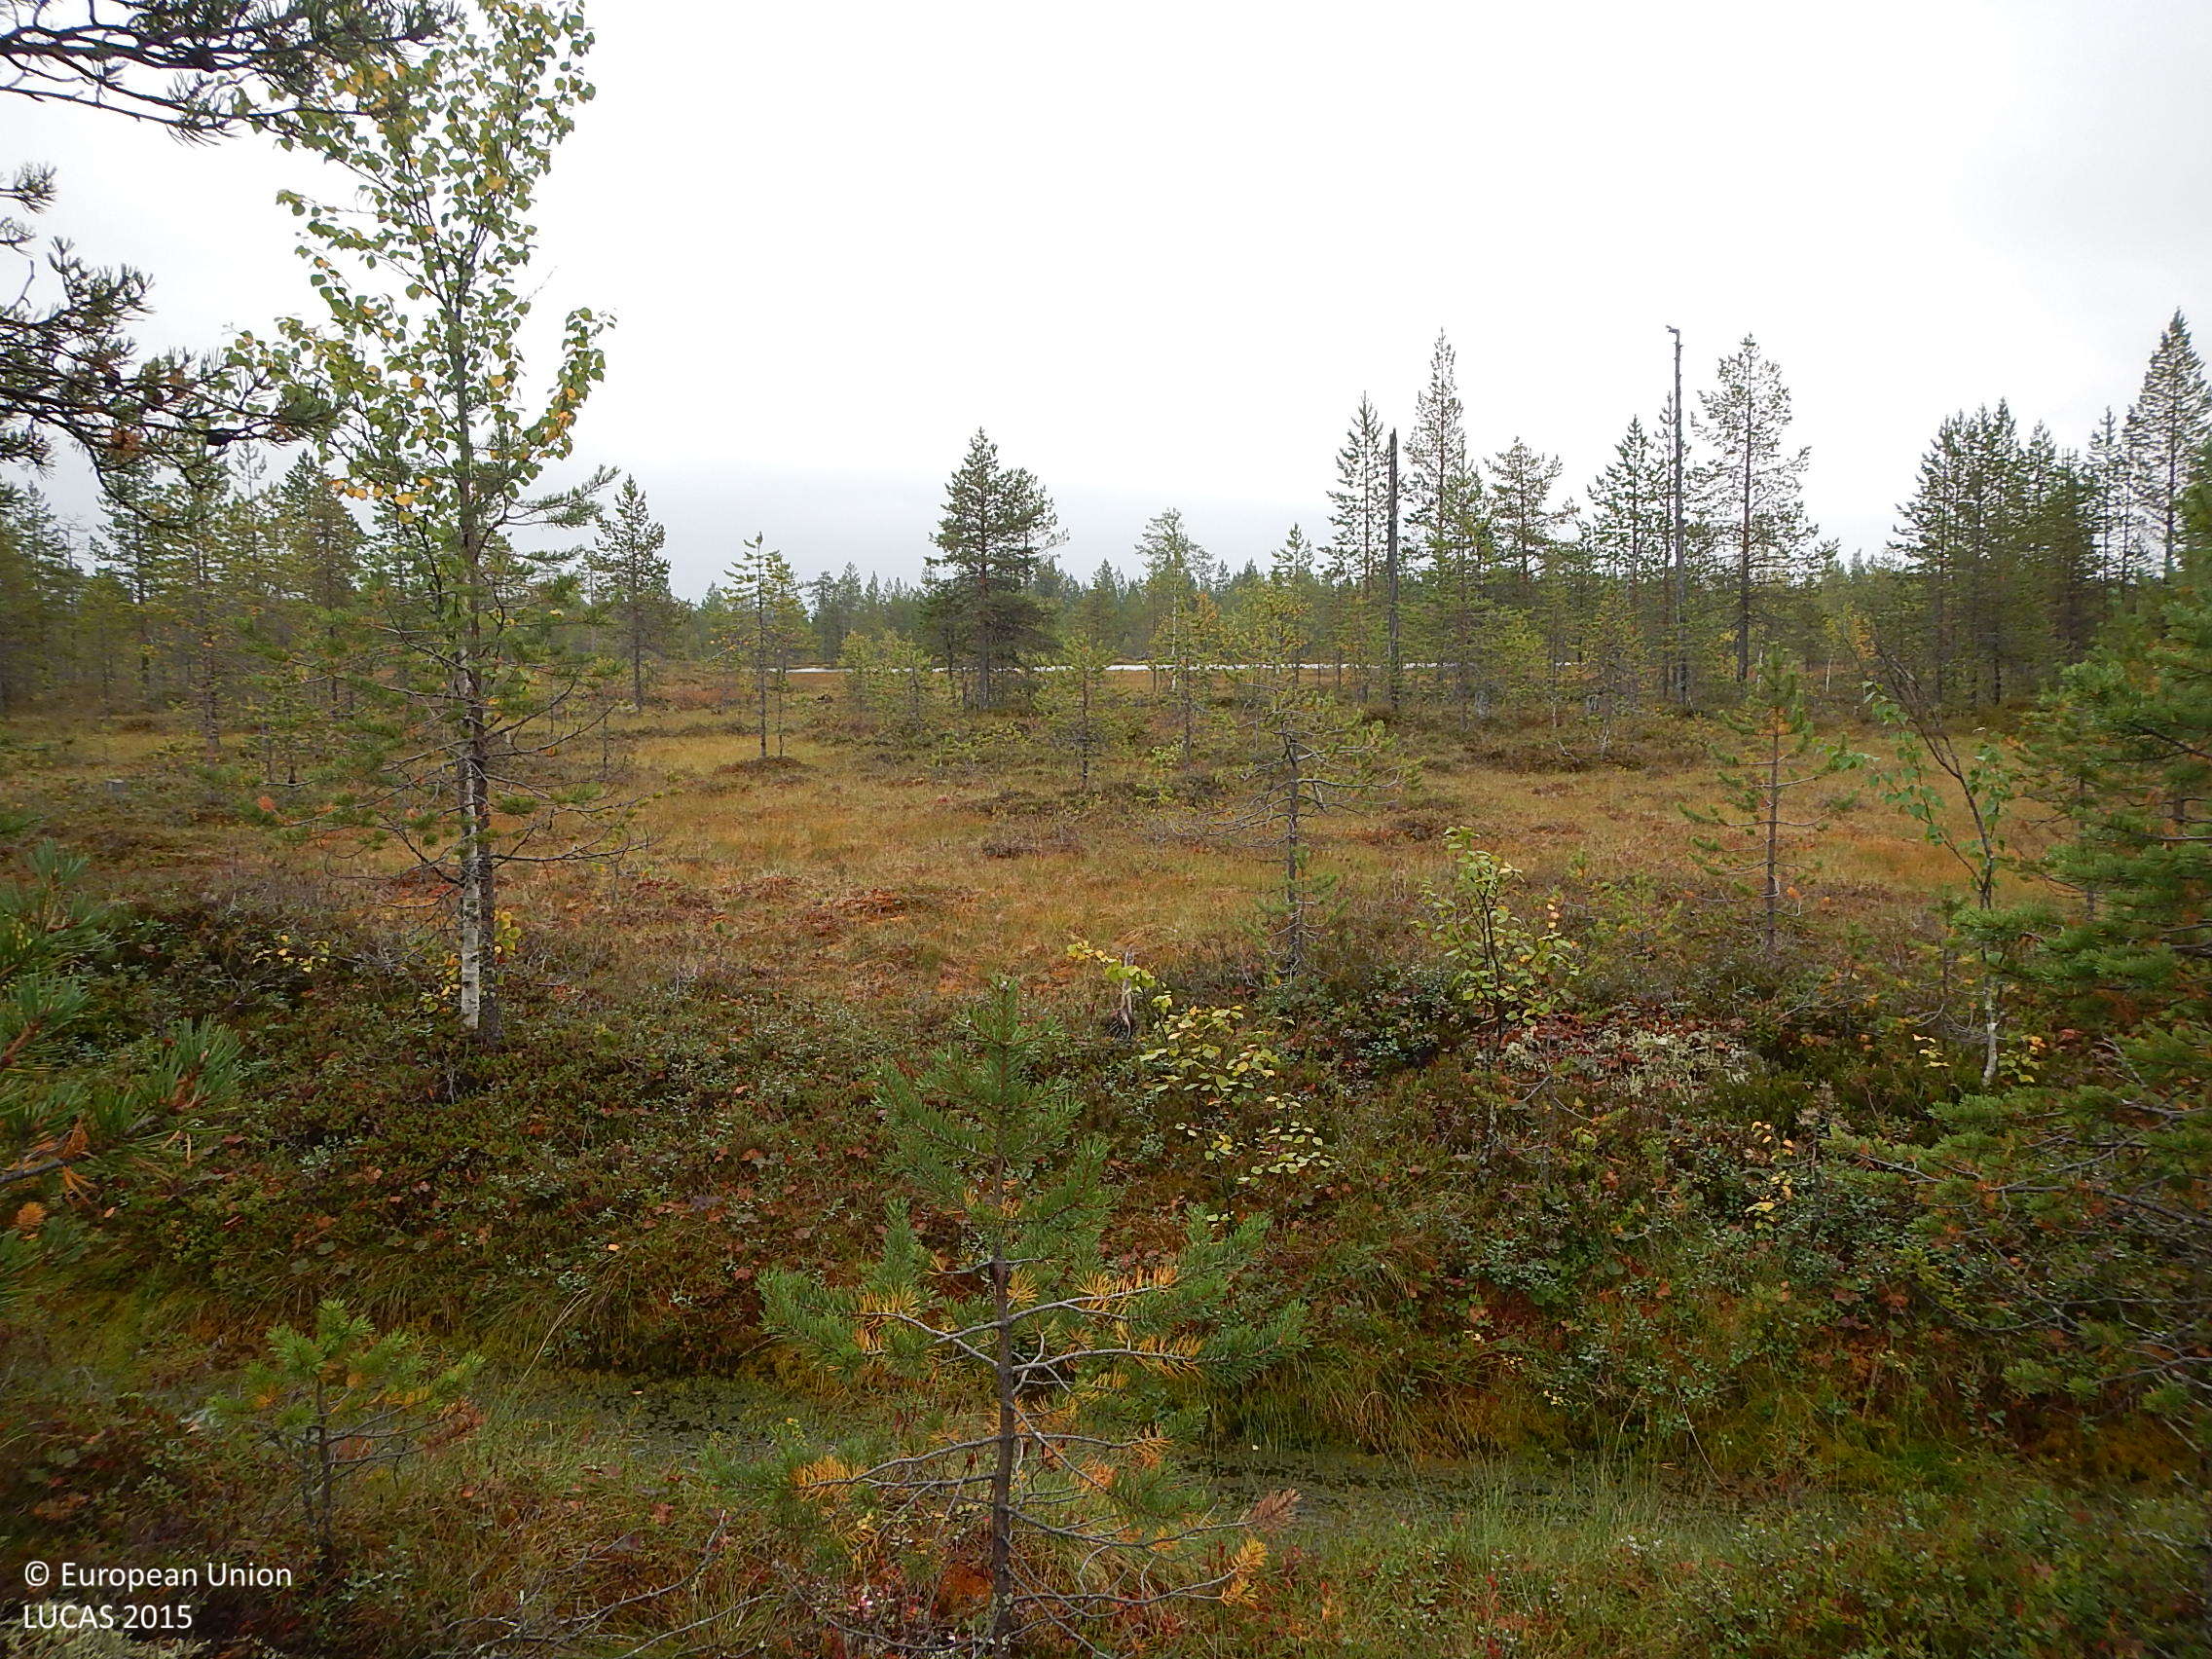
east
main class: Woodland
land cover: Pine dominated coniferous woodland
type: mire and swamp forests
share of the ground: 50 - 75 %
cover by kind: coniferous forest trees 35 %, shrubs 35 %, broadleaved forest trees 10 %, herbaceous plants 10 %, lichens and mosses 10 %
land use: Forestry
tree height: < 5 m
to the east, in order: Pine dominated coniferous woodland; Ditches and canals; Pine dominated coniferous woodland; Ditches and canals; Pine dominated mixed woodland; Peatbogs; Single bushes/trees; Peatbogs; Inland fresh water bodies; Pine dominated coniferous woodland; Pine dominated mixed woodland; Ditches and canals; Pine dominated mixed woodland
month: August
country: FI
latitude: 65.9329
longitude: 27.2794
